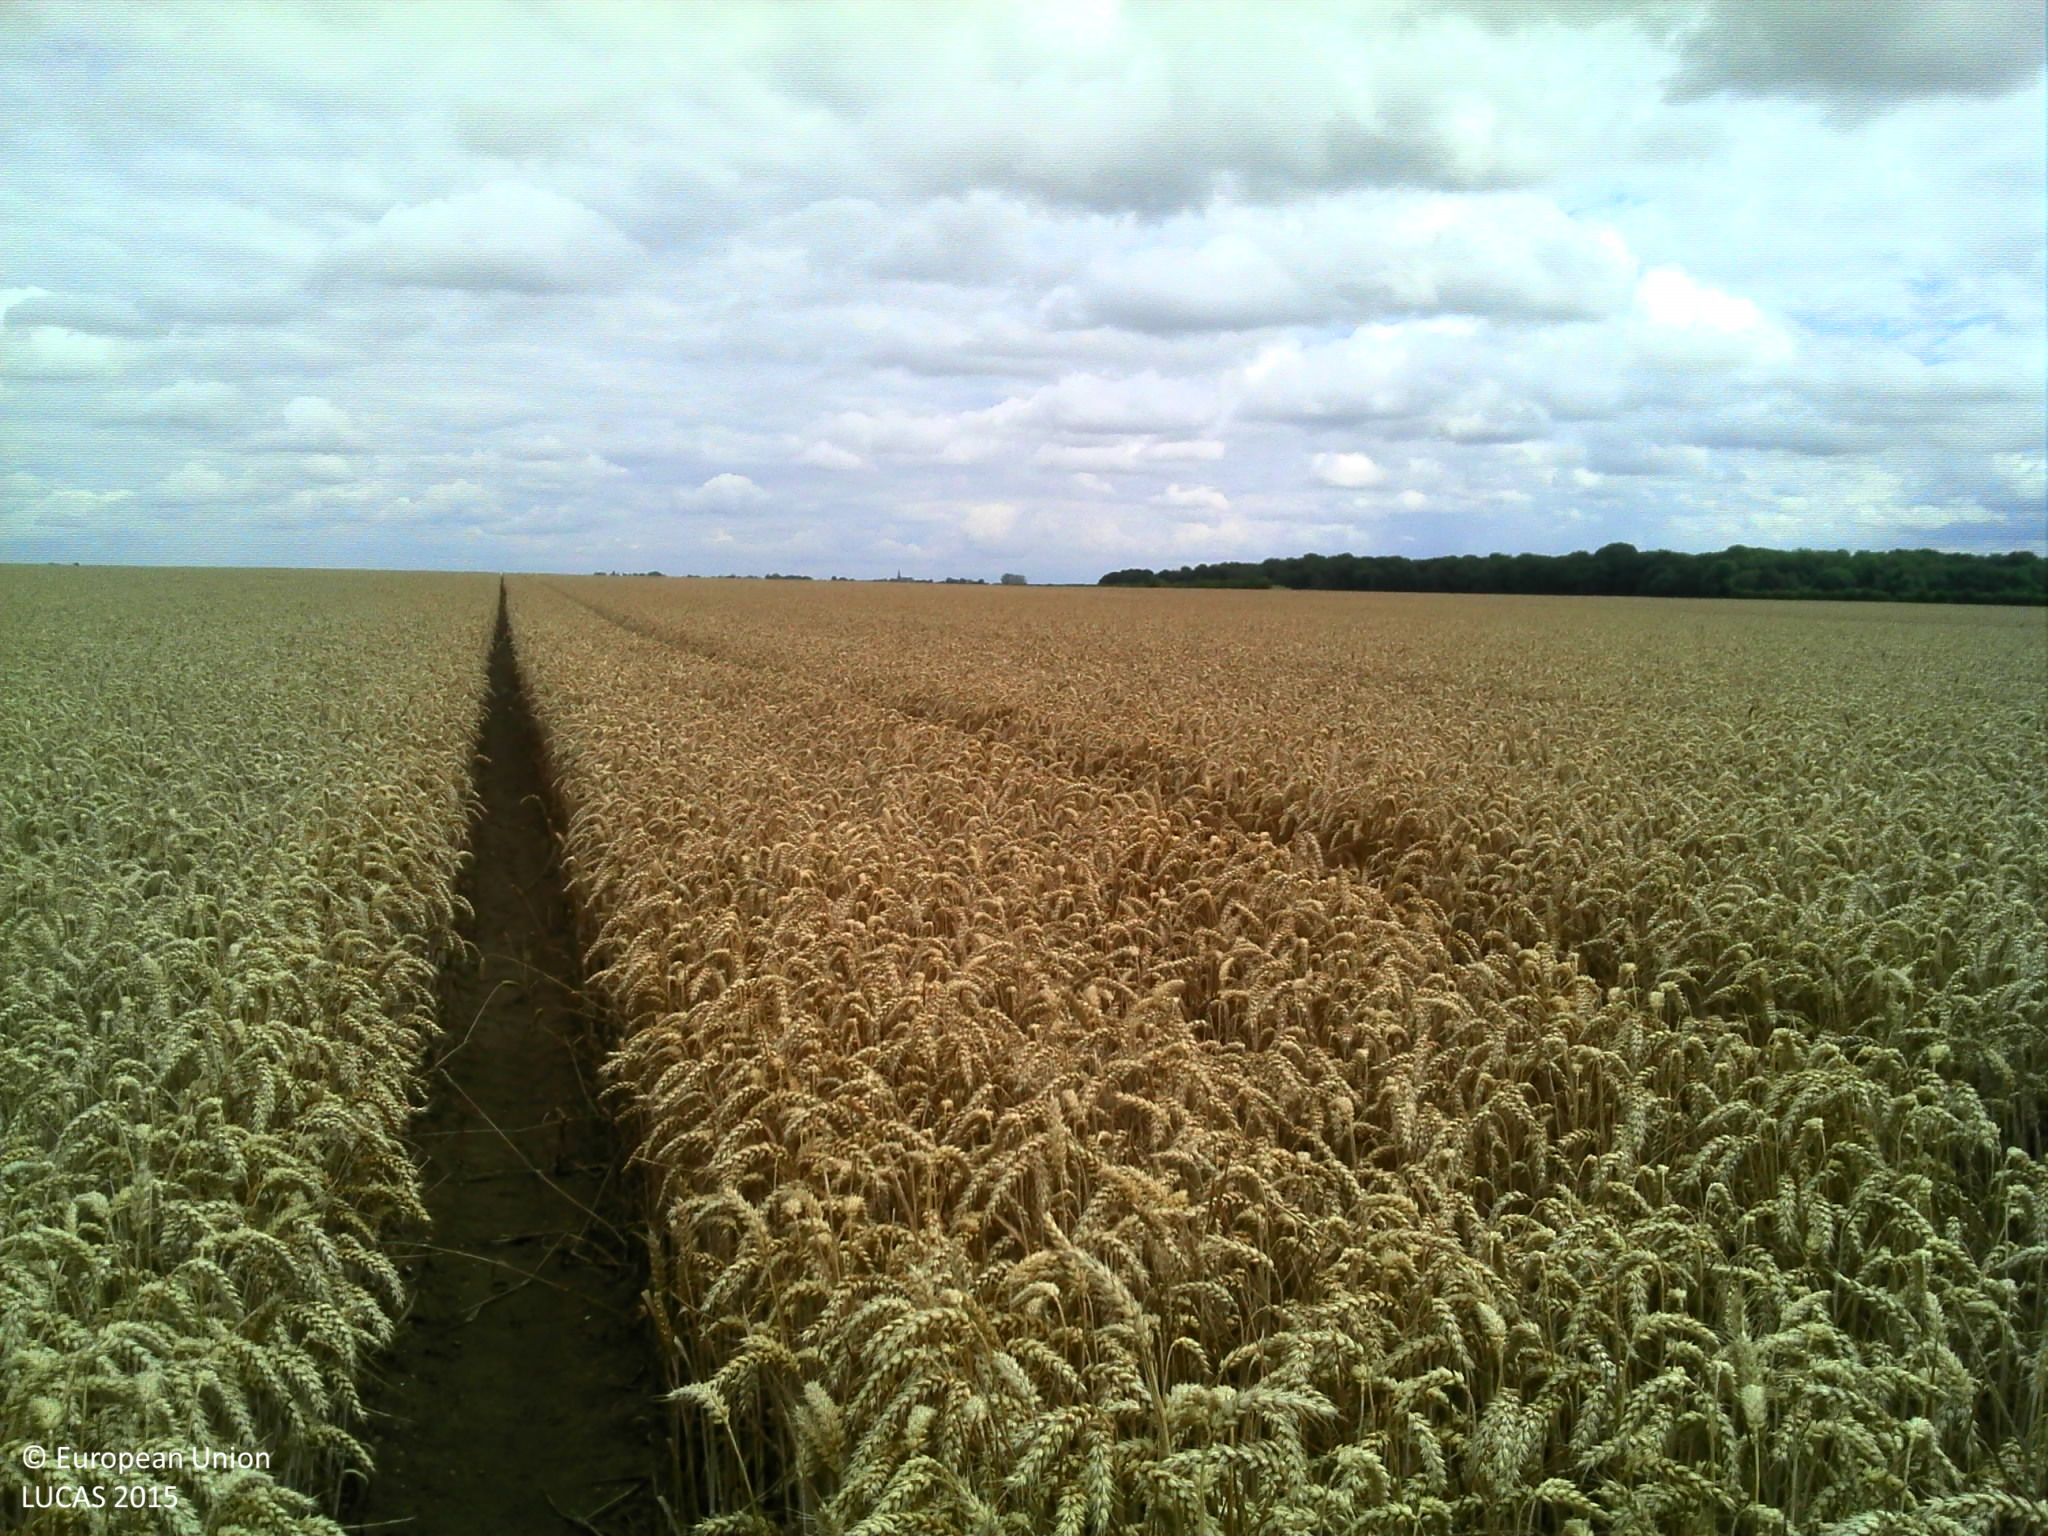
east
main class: Cropland
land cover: Common wheat
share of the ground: > 75 %
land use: Agriculture (excluding fallow land and kitchen gardens)
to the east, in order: Common wheat
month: July
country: FR
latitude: 49.8481
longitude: 2.5196
